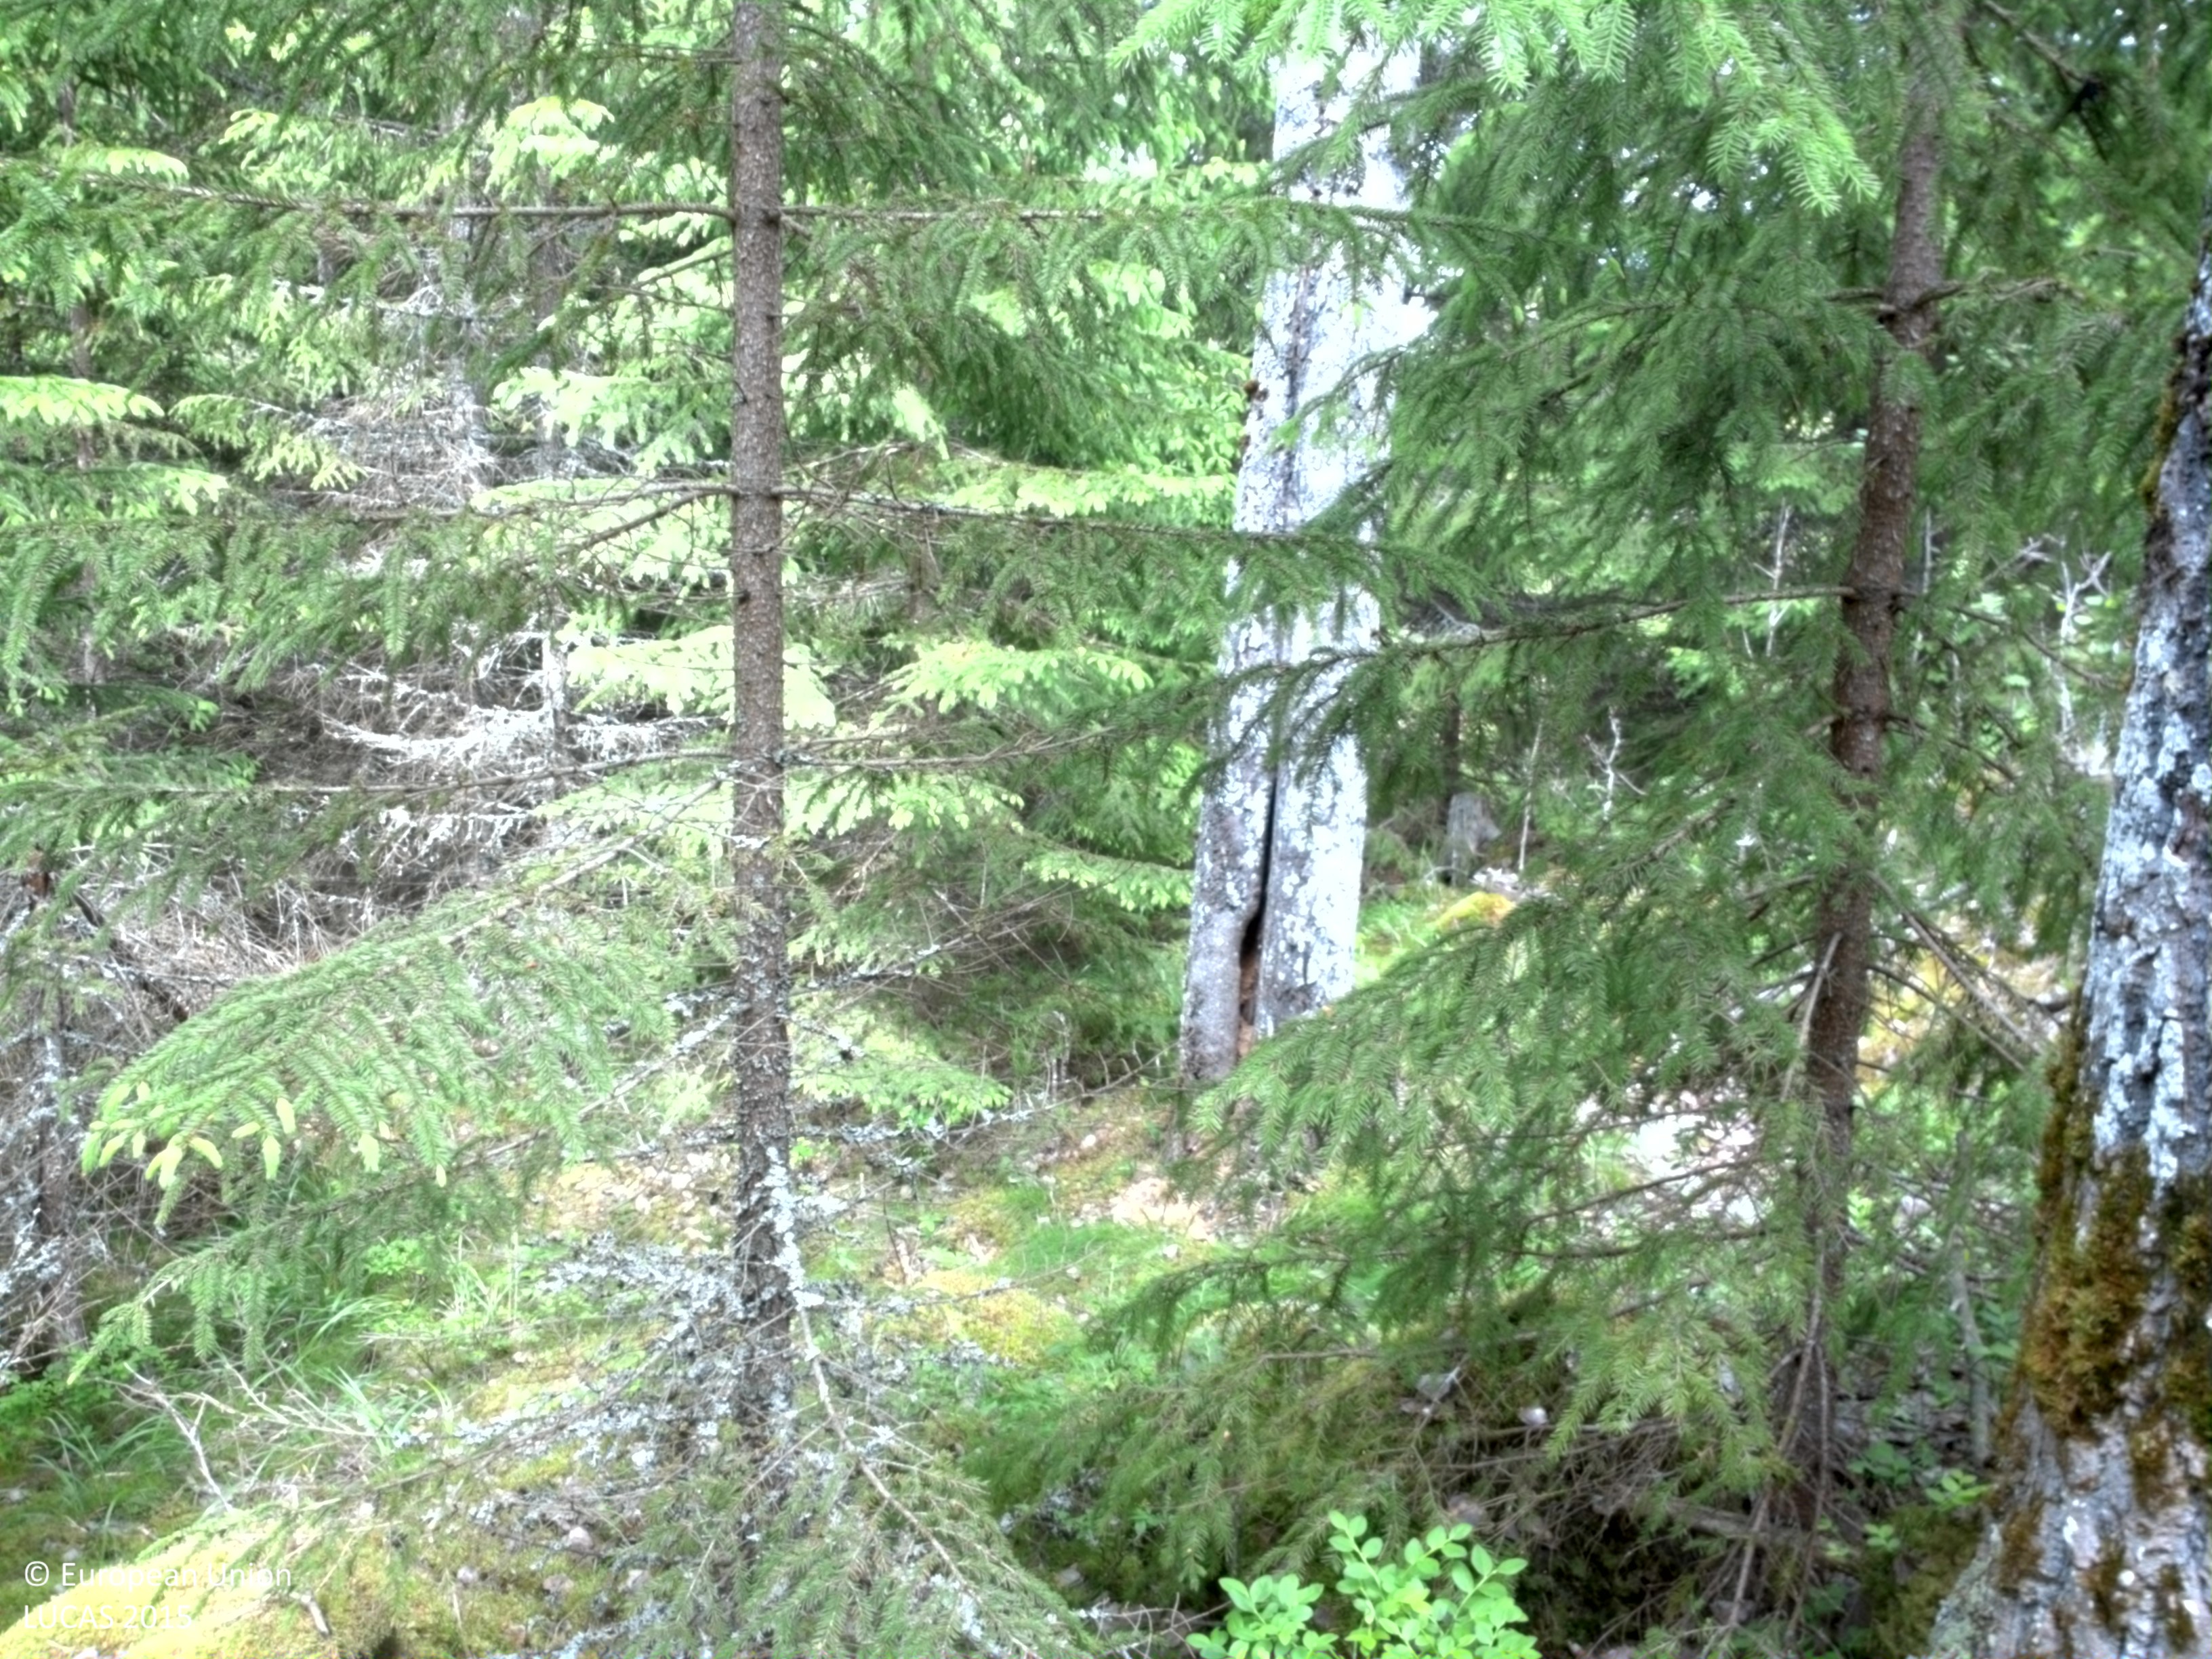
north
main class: Woodland
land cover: Spruce dominated coniferous woodland
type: boreal forest
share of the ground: 50 - 75 %
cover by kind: coniferous forest trees 70 %, lichens and mosses 25 %, herbaceous plants 5 %
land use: Forestry
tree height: < 5 m
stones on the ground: > 50 %
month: June
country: SE
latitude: 58.6608
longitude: 15.6307
